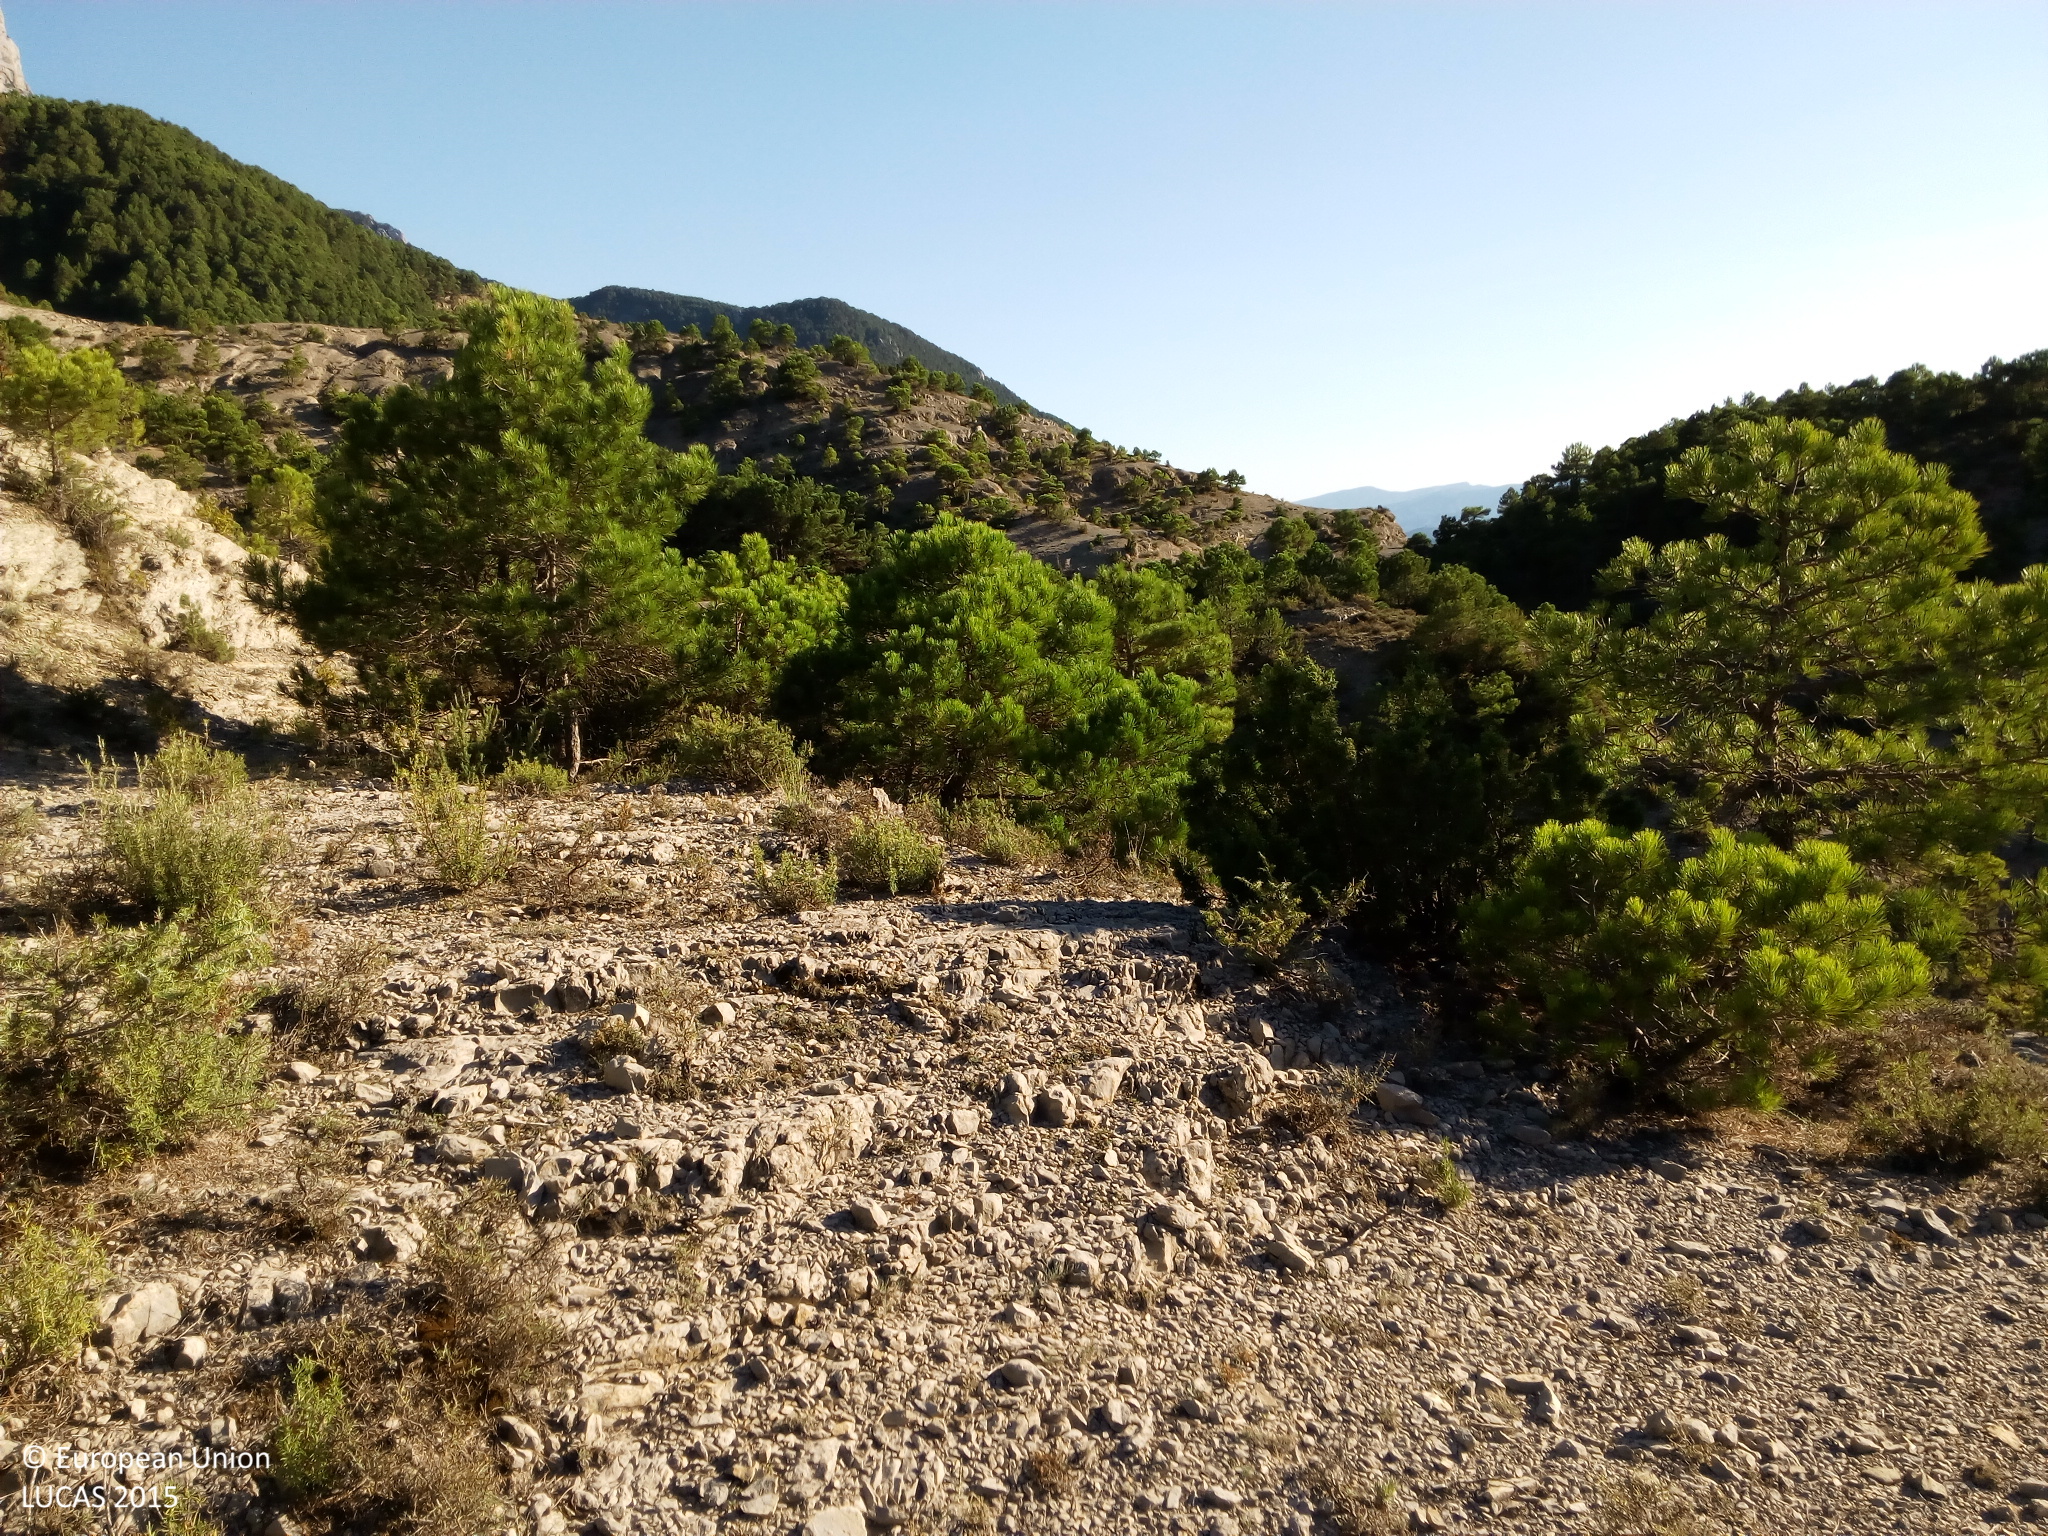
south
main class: Woodland
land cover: Pine dominated coniferous woodland
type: coniferous forest of the mediterranean region
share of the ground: > 75 %
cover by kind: coniferous forest trees 80 %, consolidated bare surface 20 %
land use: Semi-natural and natural areas not in use
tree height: > 5 m
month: August
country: ES
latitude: 42.5211
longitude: 0.1793
